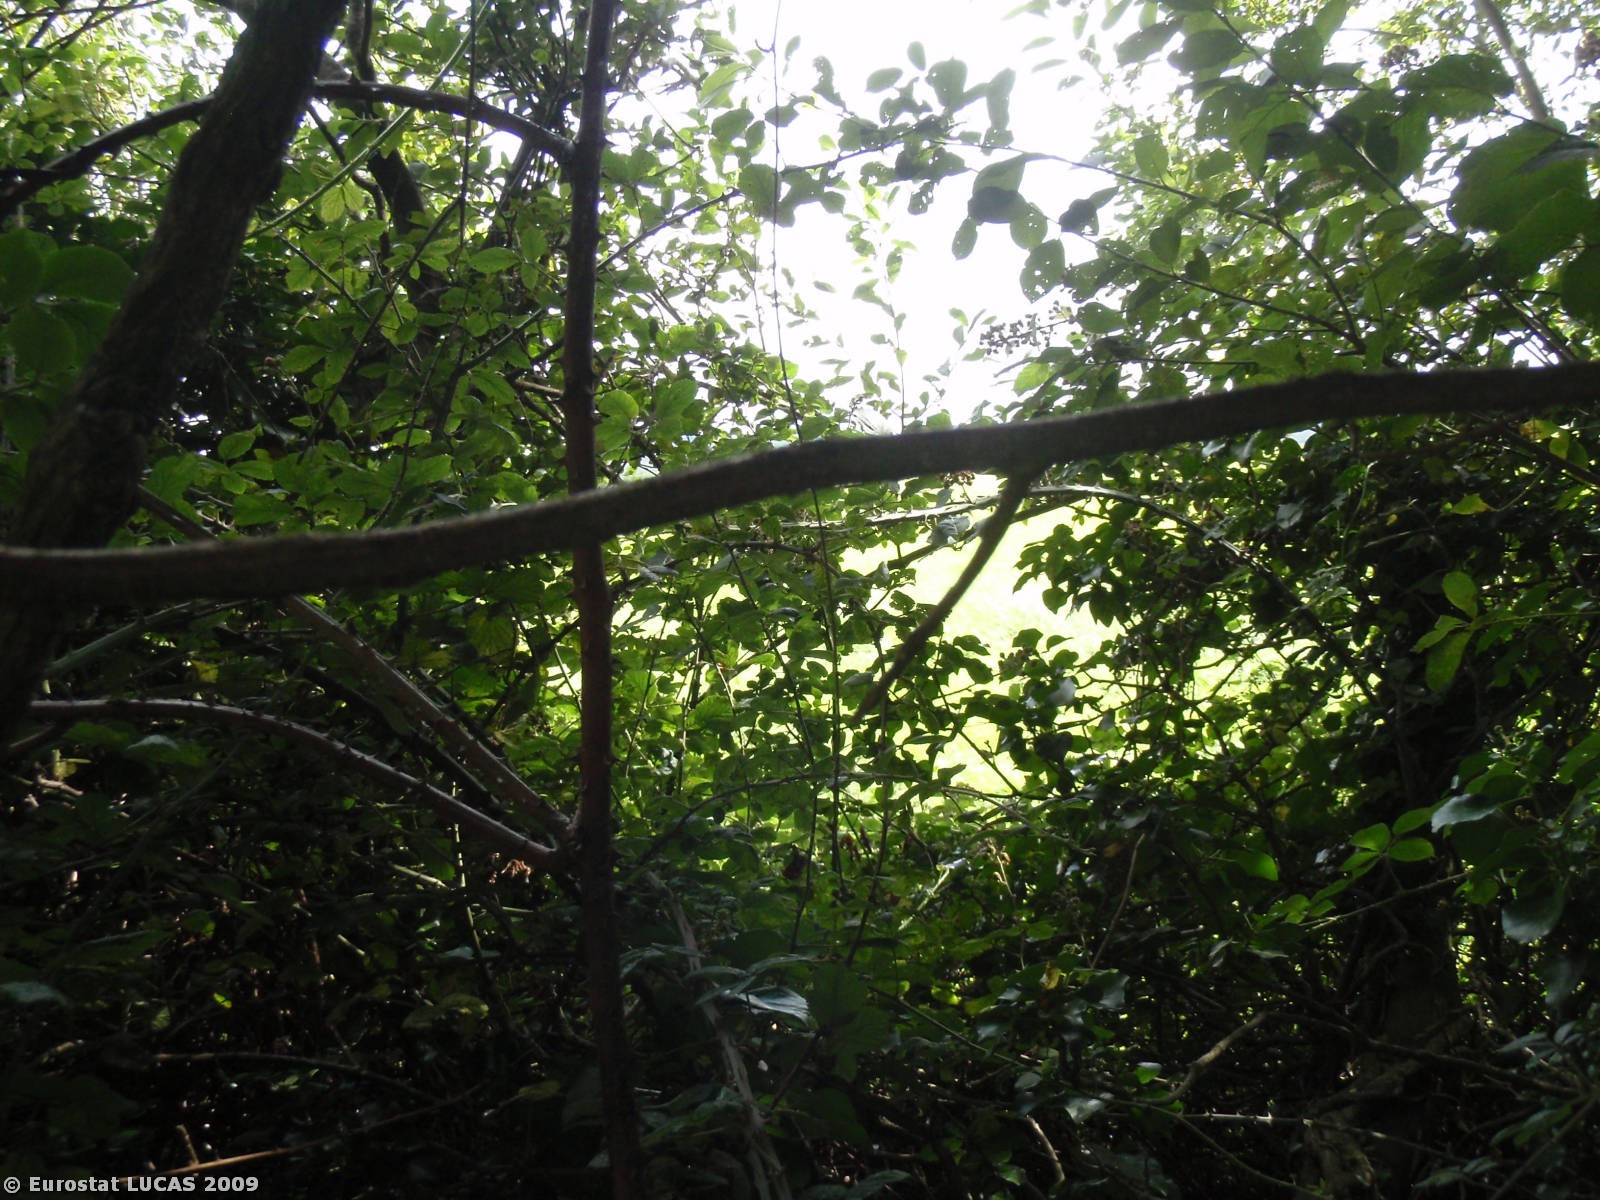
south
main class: Woodland
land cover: Broadleaved woodland
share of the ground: > 75 %
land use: Agriculture (excluding fallow land and kitchen gardens)
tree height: > 5 m
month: August
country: GB
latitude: 50.8545
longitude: -2.6979
